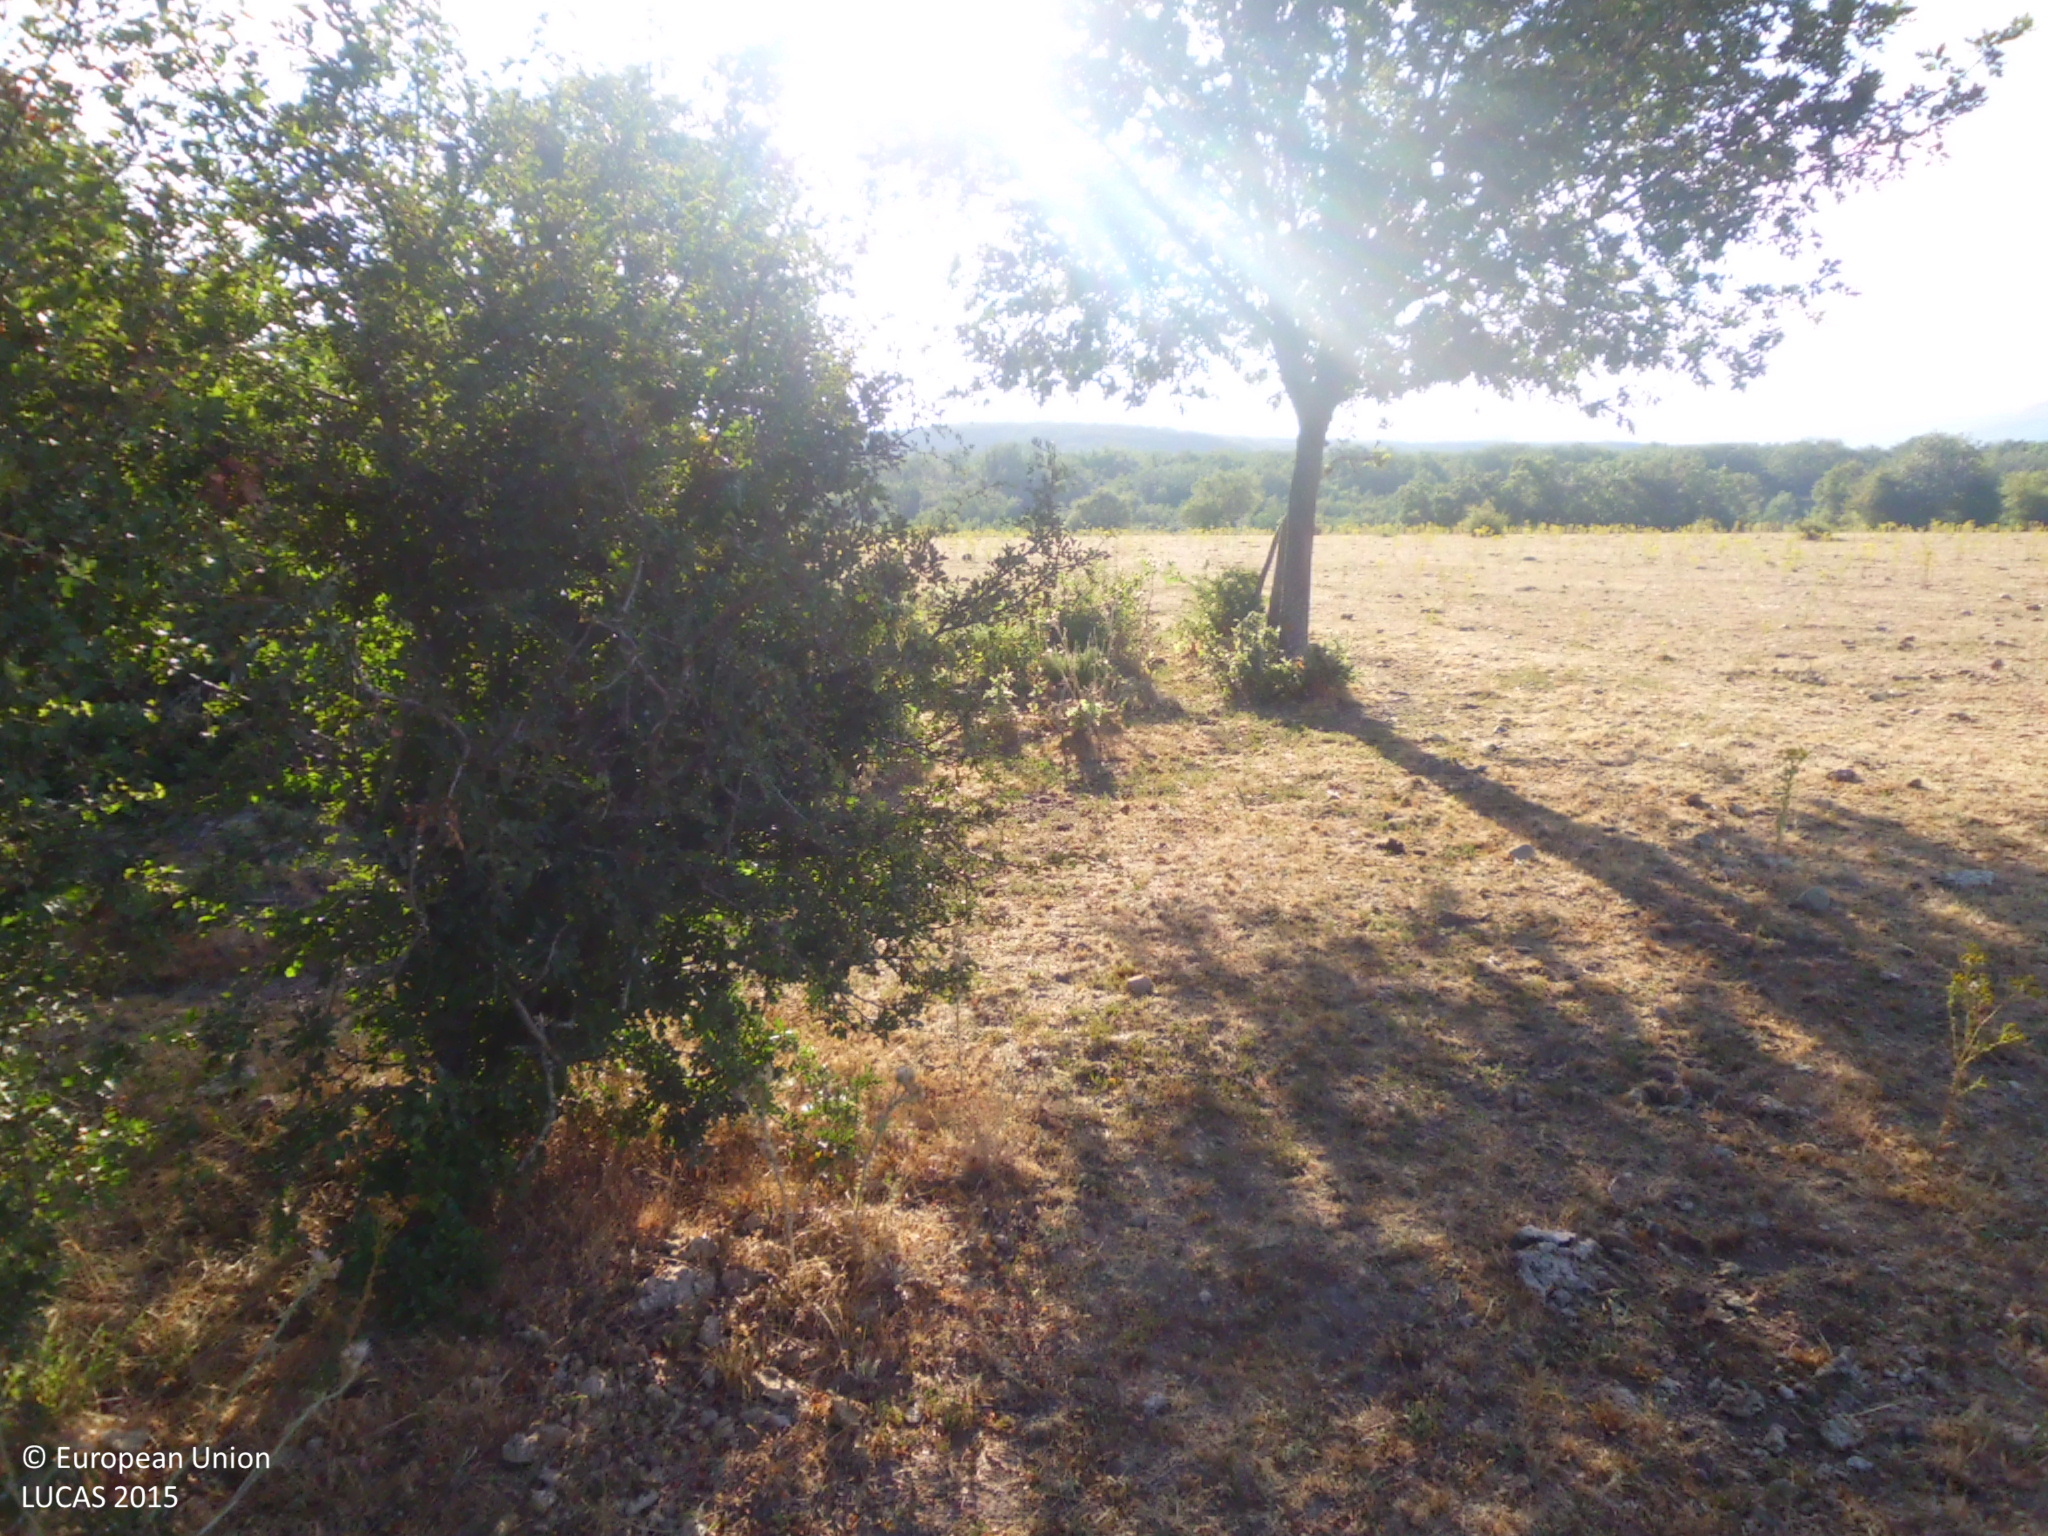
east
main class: Grassland
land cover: Grassland with sparse tree/shrub cover
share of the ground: 25 - 50 %
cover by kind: unconsolidated bare surface 50 %, herbaceous plants 40 %, broadleaved forest trees 5 %, shrubs 5 %
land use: Agriculture (excluding fallow land and kitchen gardens)
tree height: < 5 m
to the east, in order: Grassland with sparse tree/shrub cover; Grassland without tree/shrub cover; Broadleaved woodland
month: July
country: ES
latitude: 42.6995
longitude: -4.2709
